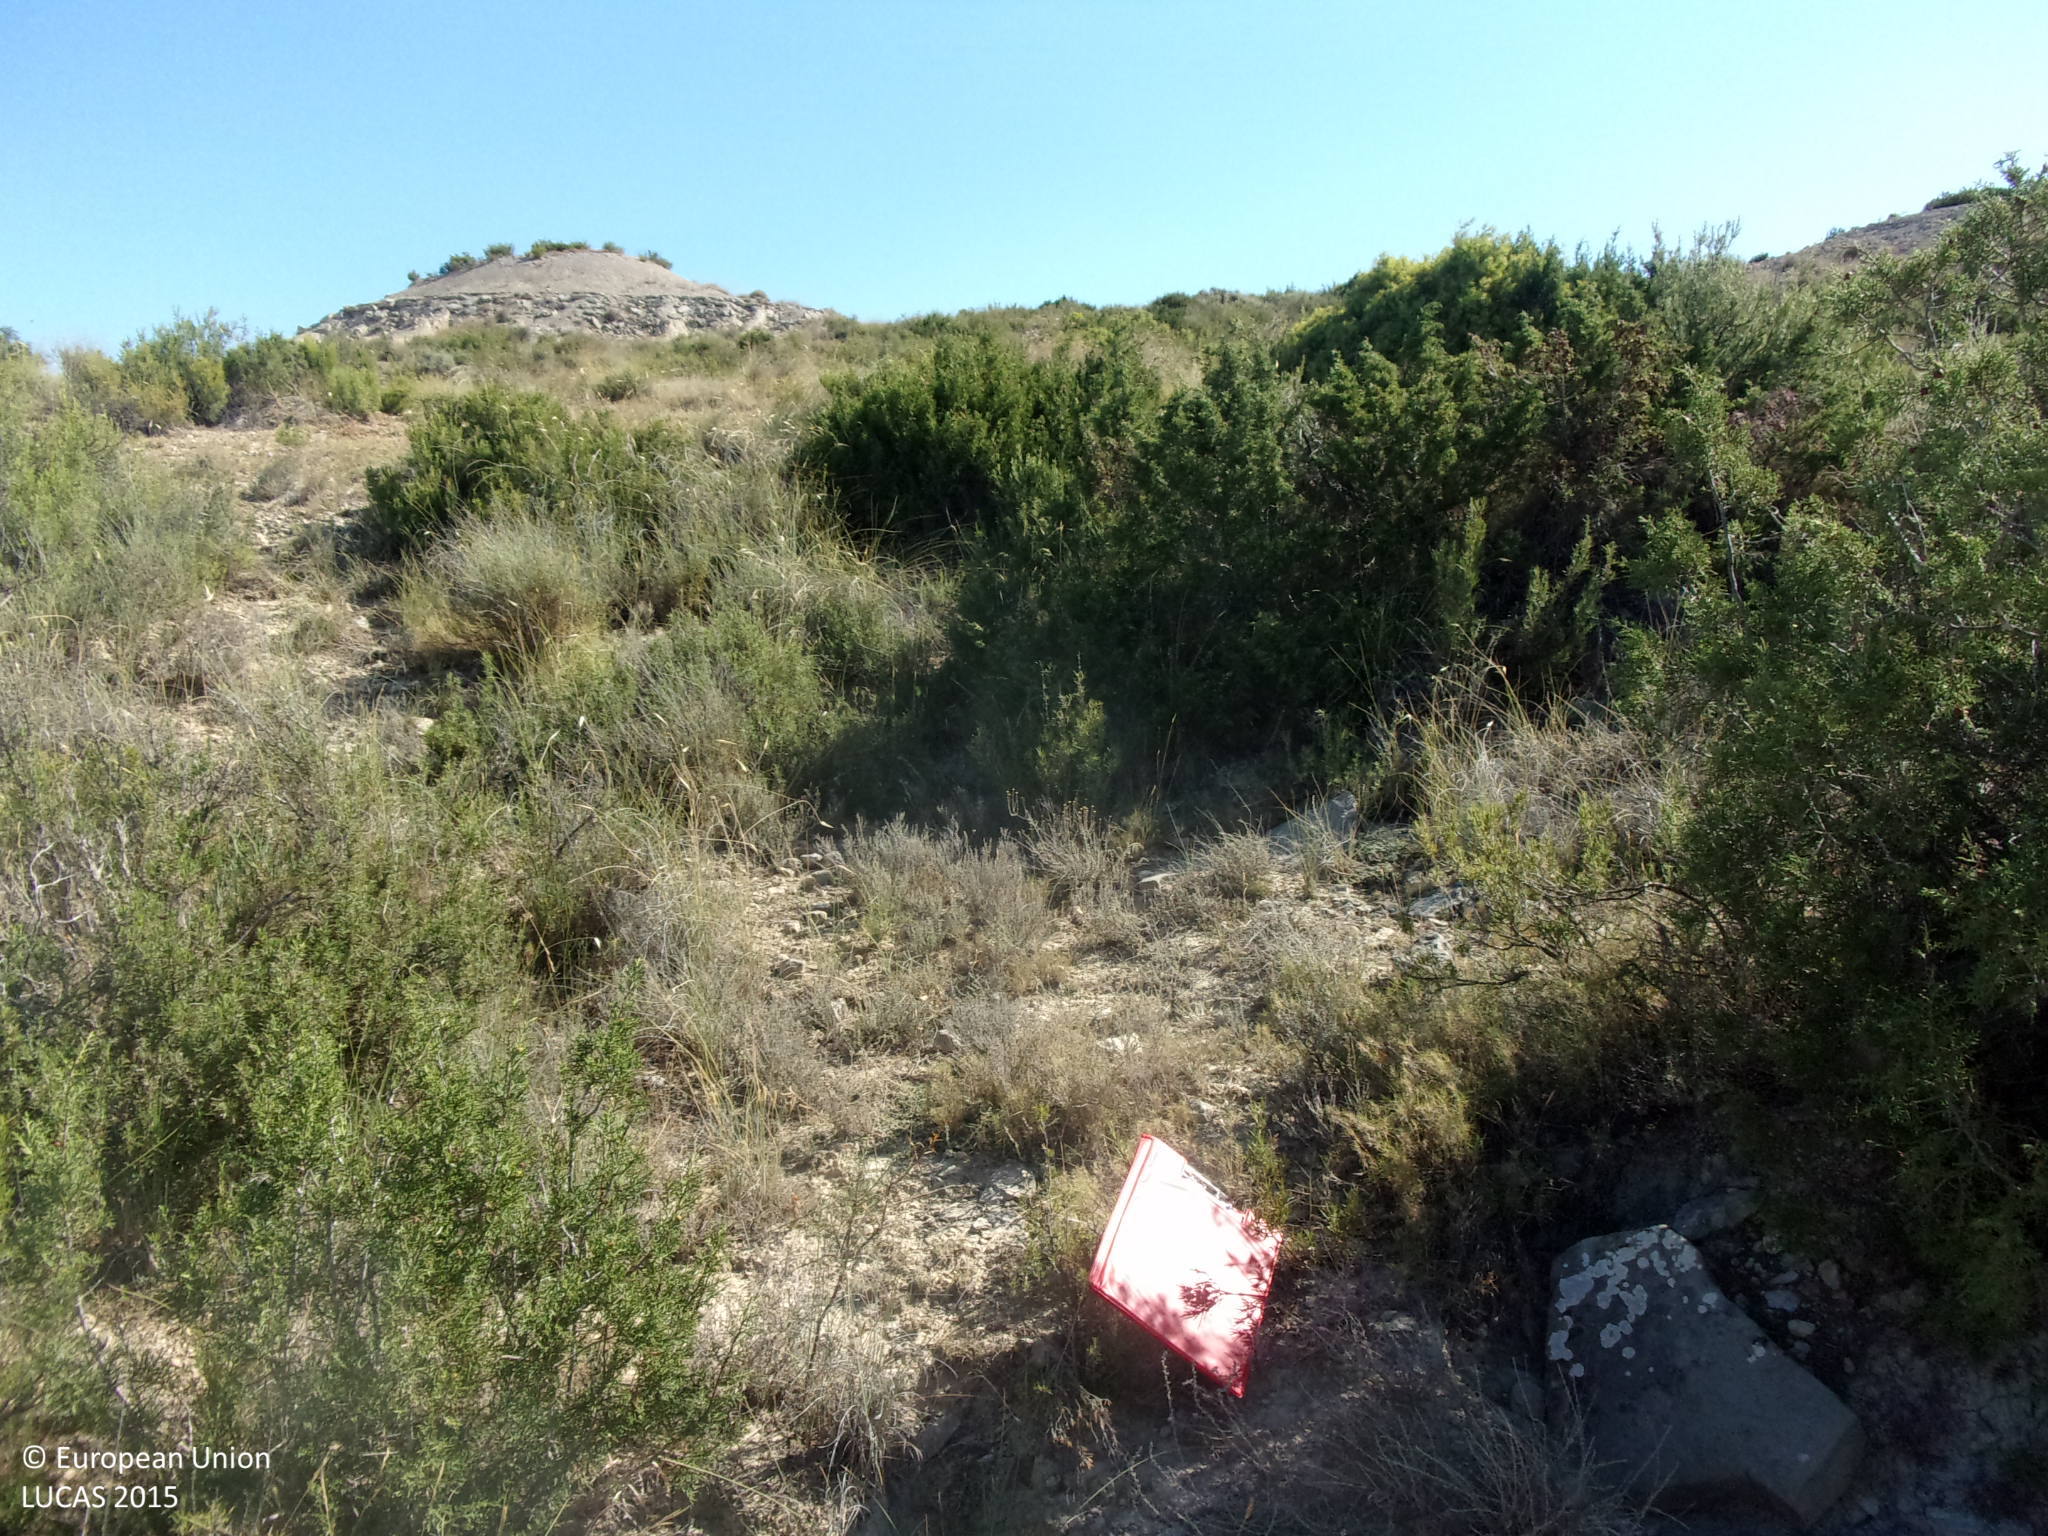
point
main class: Shrubland
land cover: Shrubland without tree cover
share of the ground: > 75 %
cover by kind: shrubs 75 %, unconsolidated bare surface 25 %
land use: Semi-natural and natural areas not in use
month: July
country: ES
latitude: 42.0646
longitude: -1.0606
